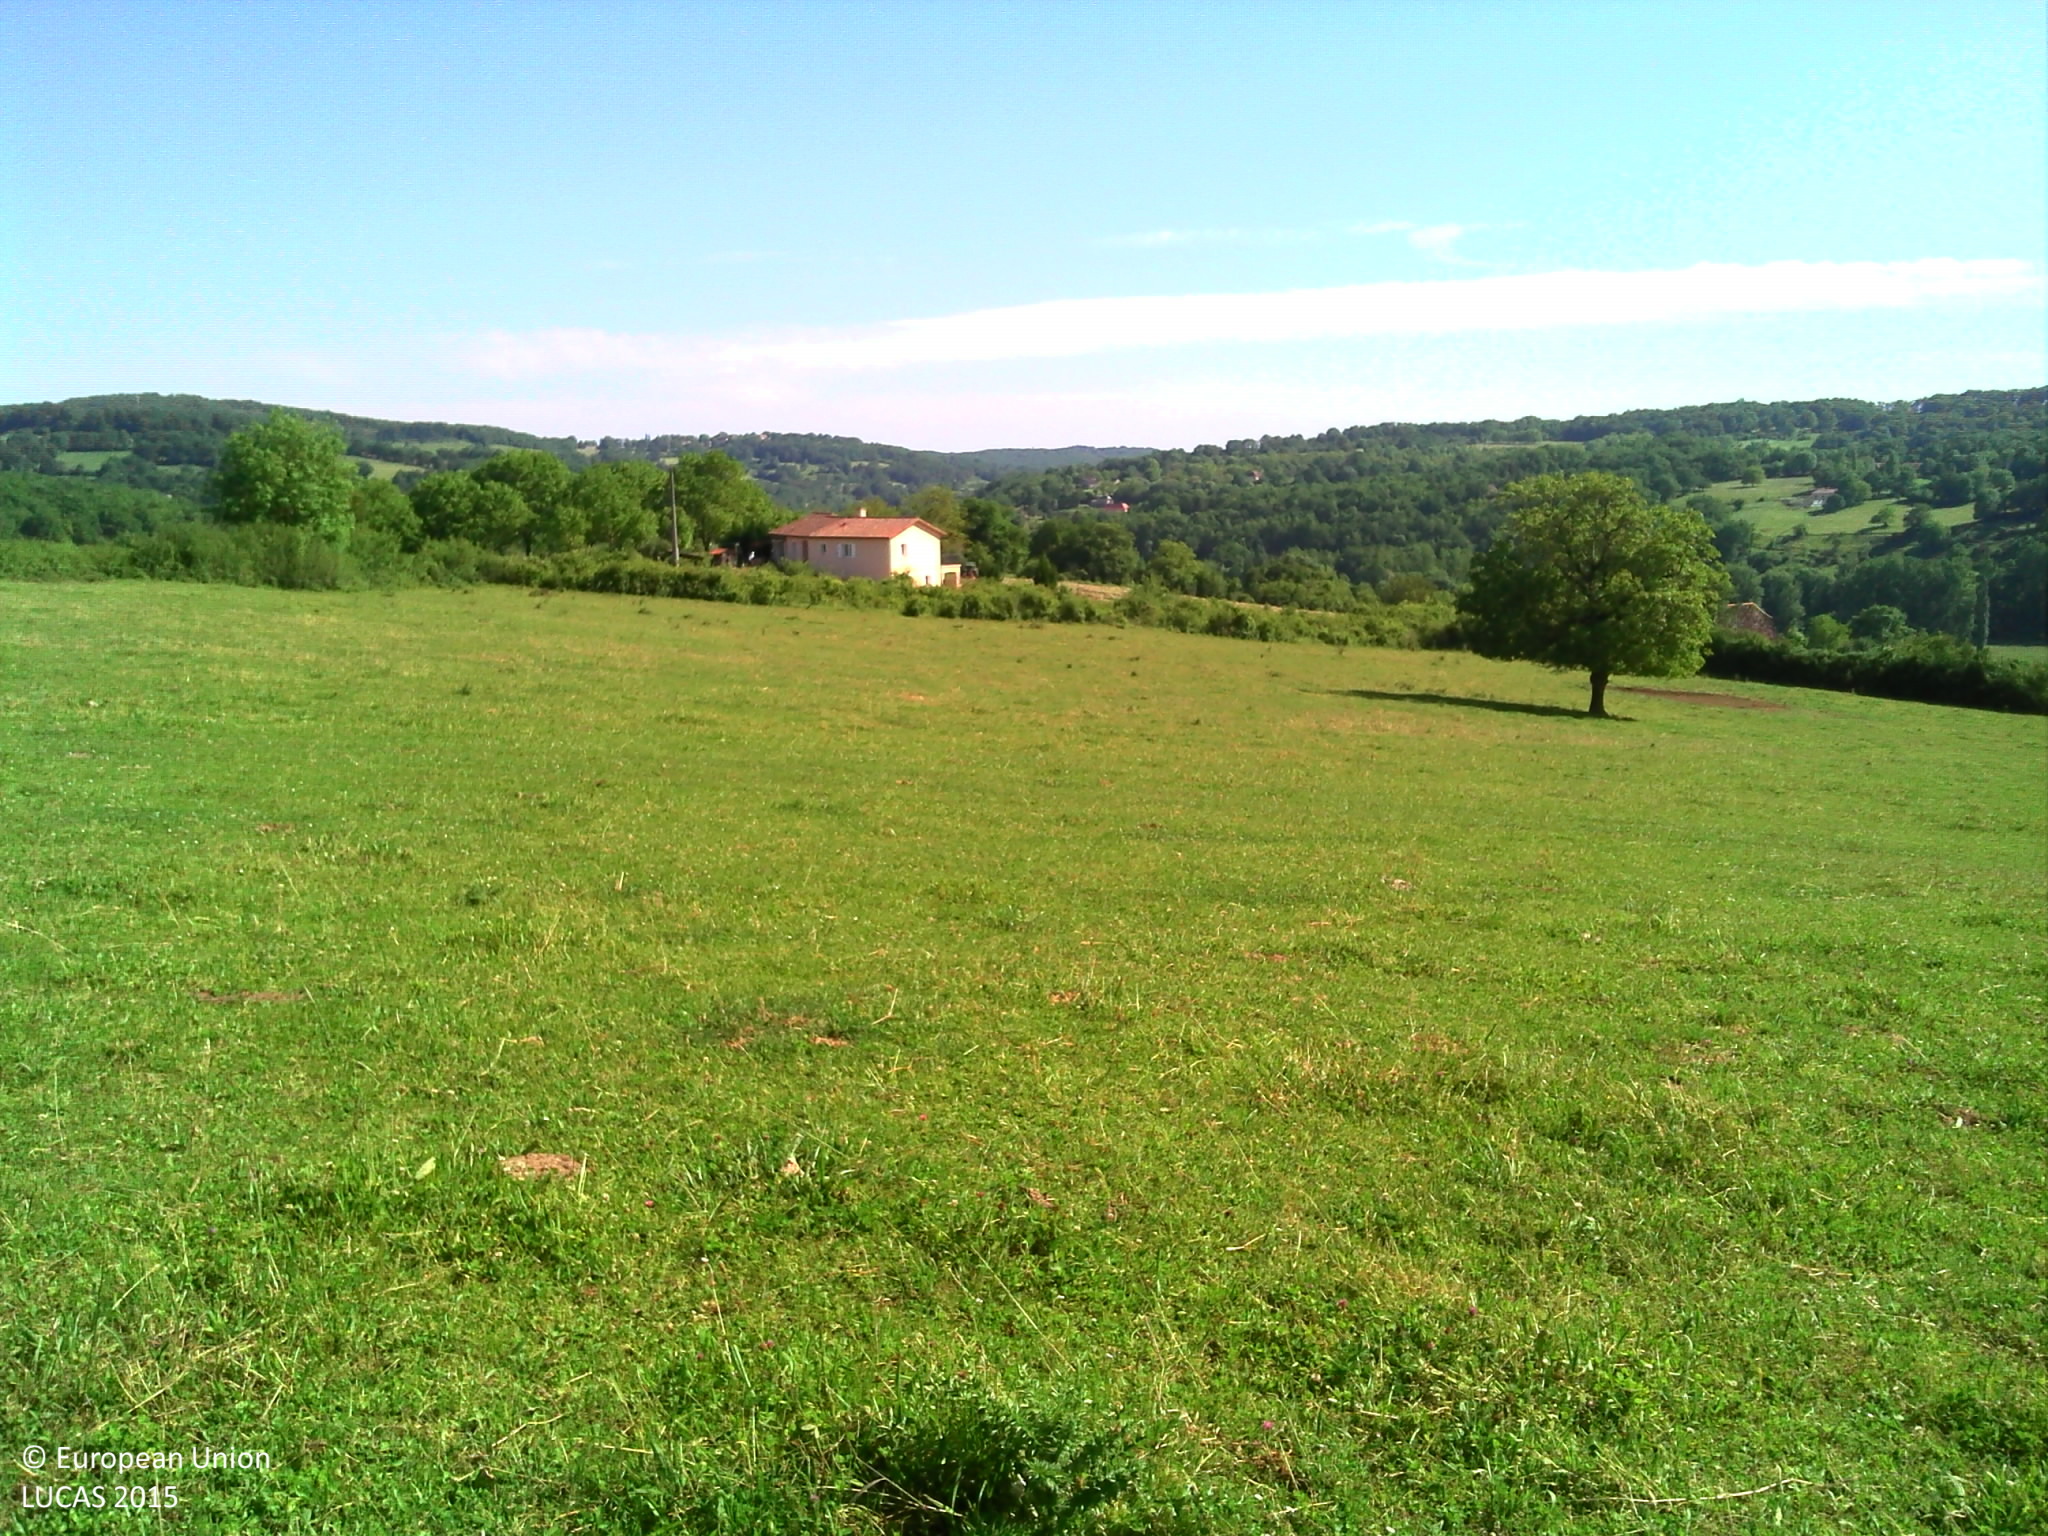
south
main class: Grassland
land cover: Grassland without tree/shrub cover
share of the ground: > 75 %
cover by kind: herbaceous plants 100 %
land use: Agriculture (excluding fallow land and kitchen gardens)
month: May
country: FR
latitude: 44.6566
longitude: 1.9920
